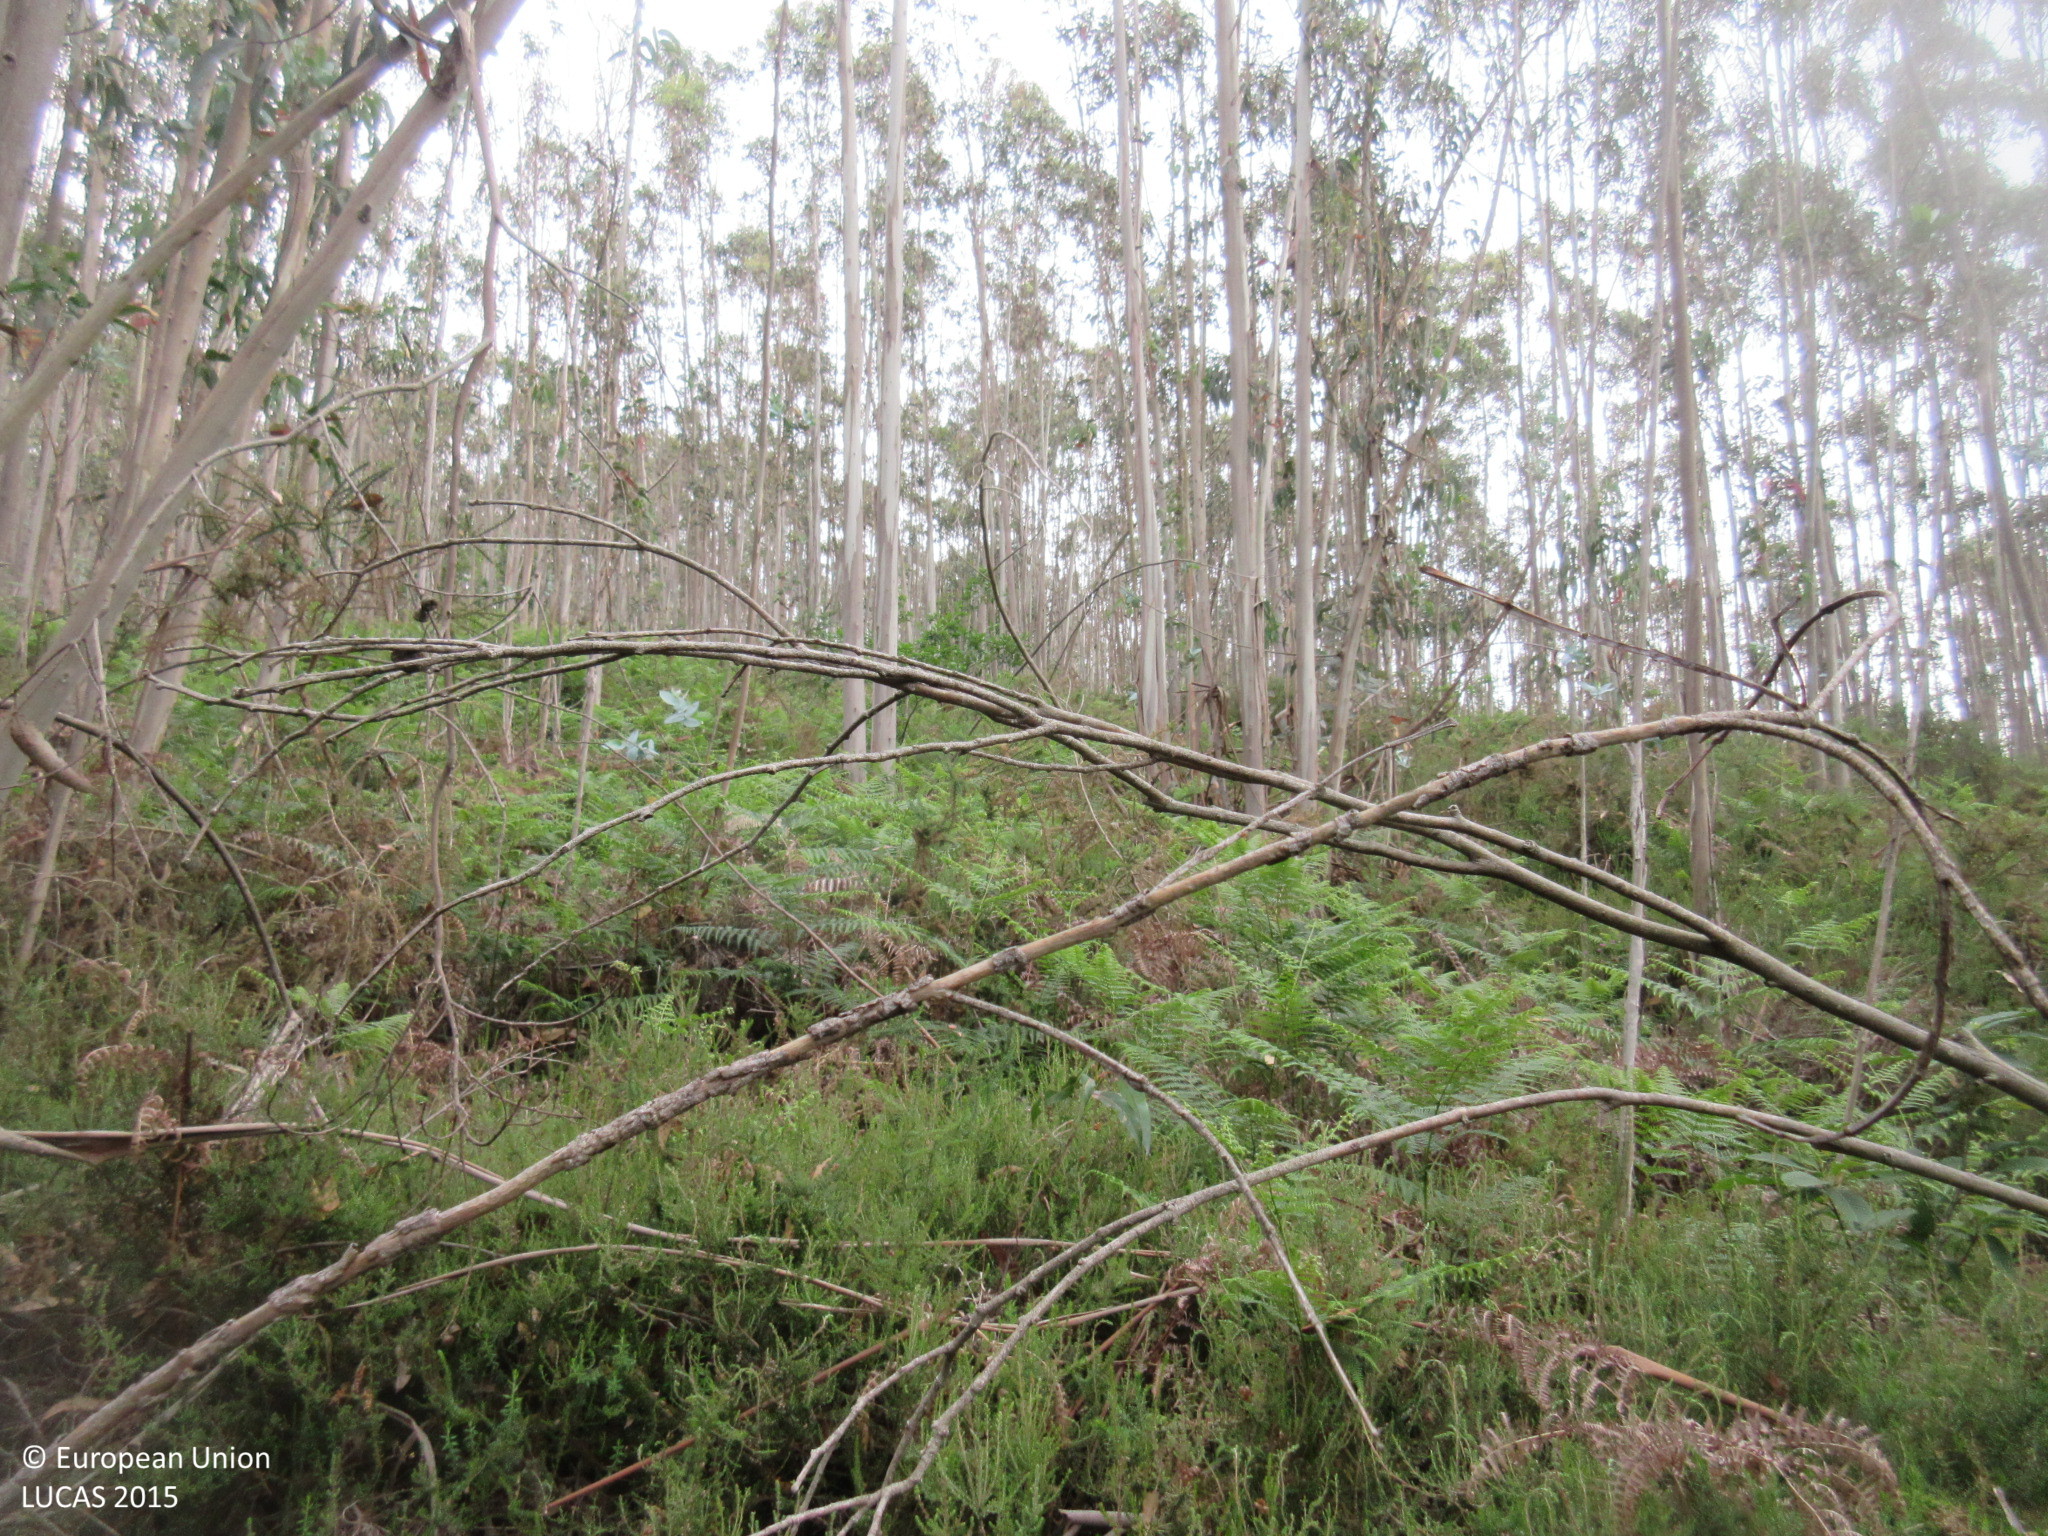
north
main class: Woodland
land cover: Broadleaved woodland
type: exotic forest
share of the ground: > 75 %
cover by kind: broadleaved forest trees 85 %, shrubs 15 %
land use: Forestry
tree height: > 5 m
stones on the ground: 10 - 25 %
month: June
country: ES
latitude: 43.4389
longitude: -5.9422
